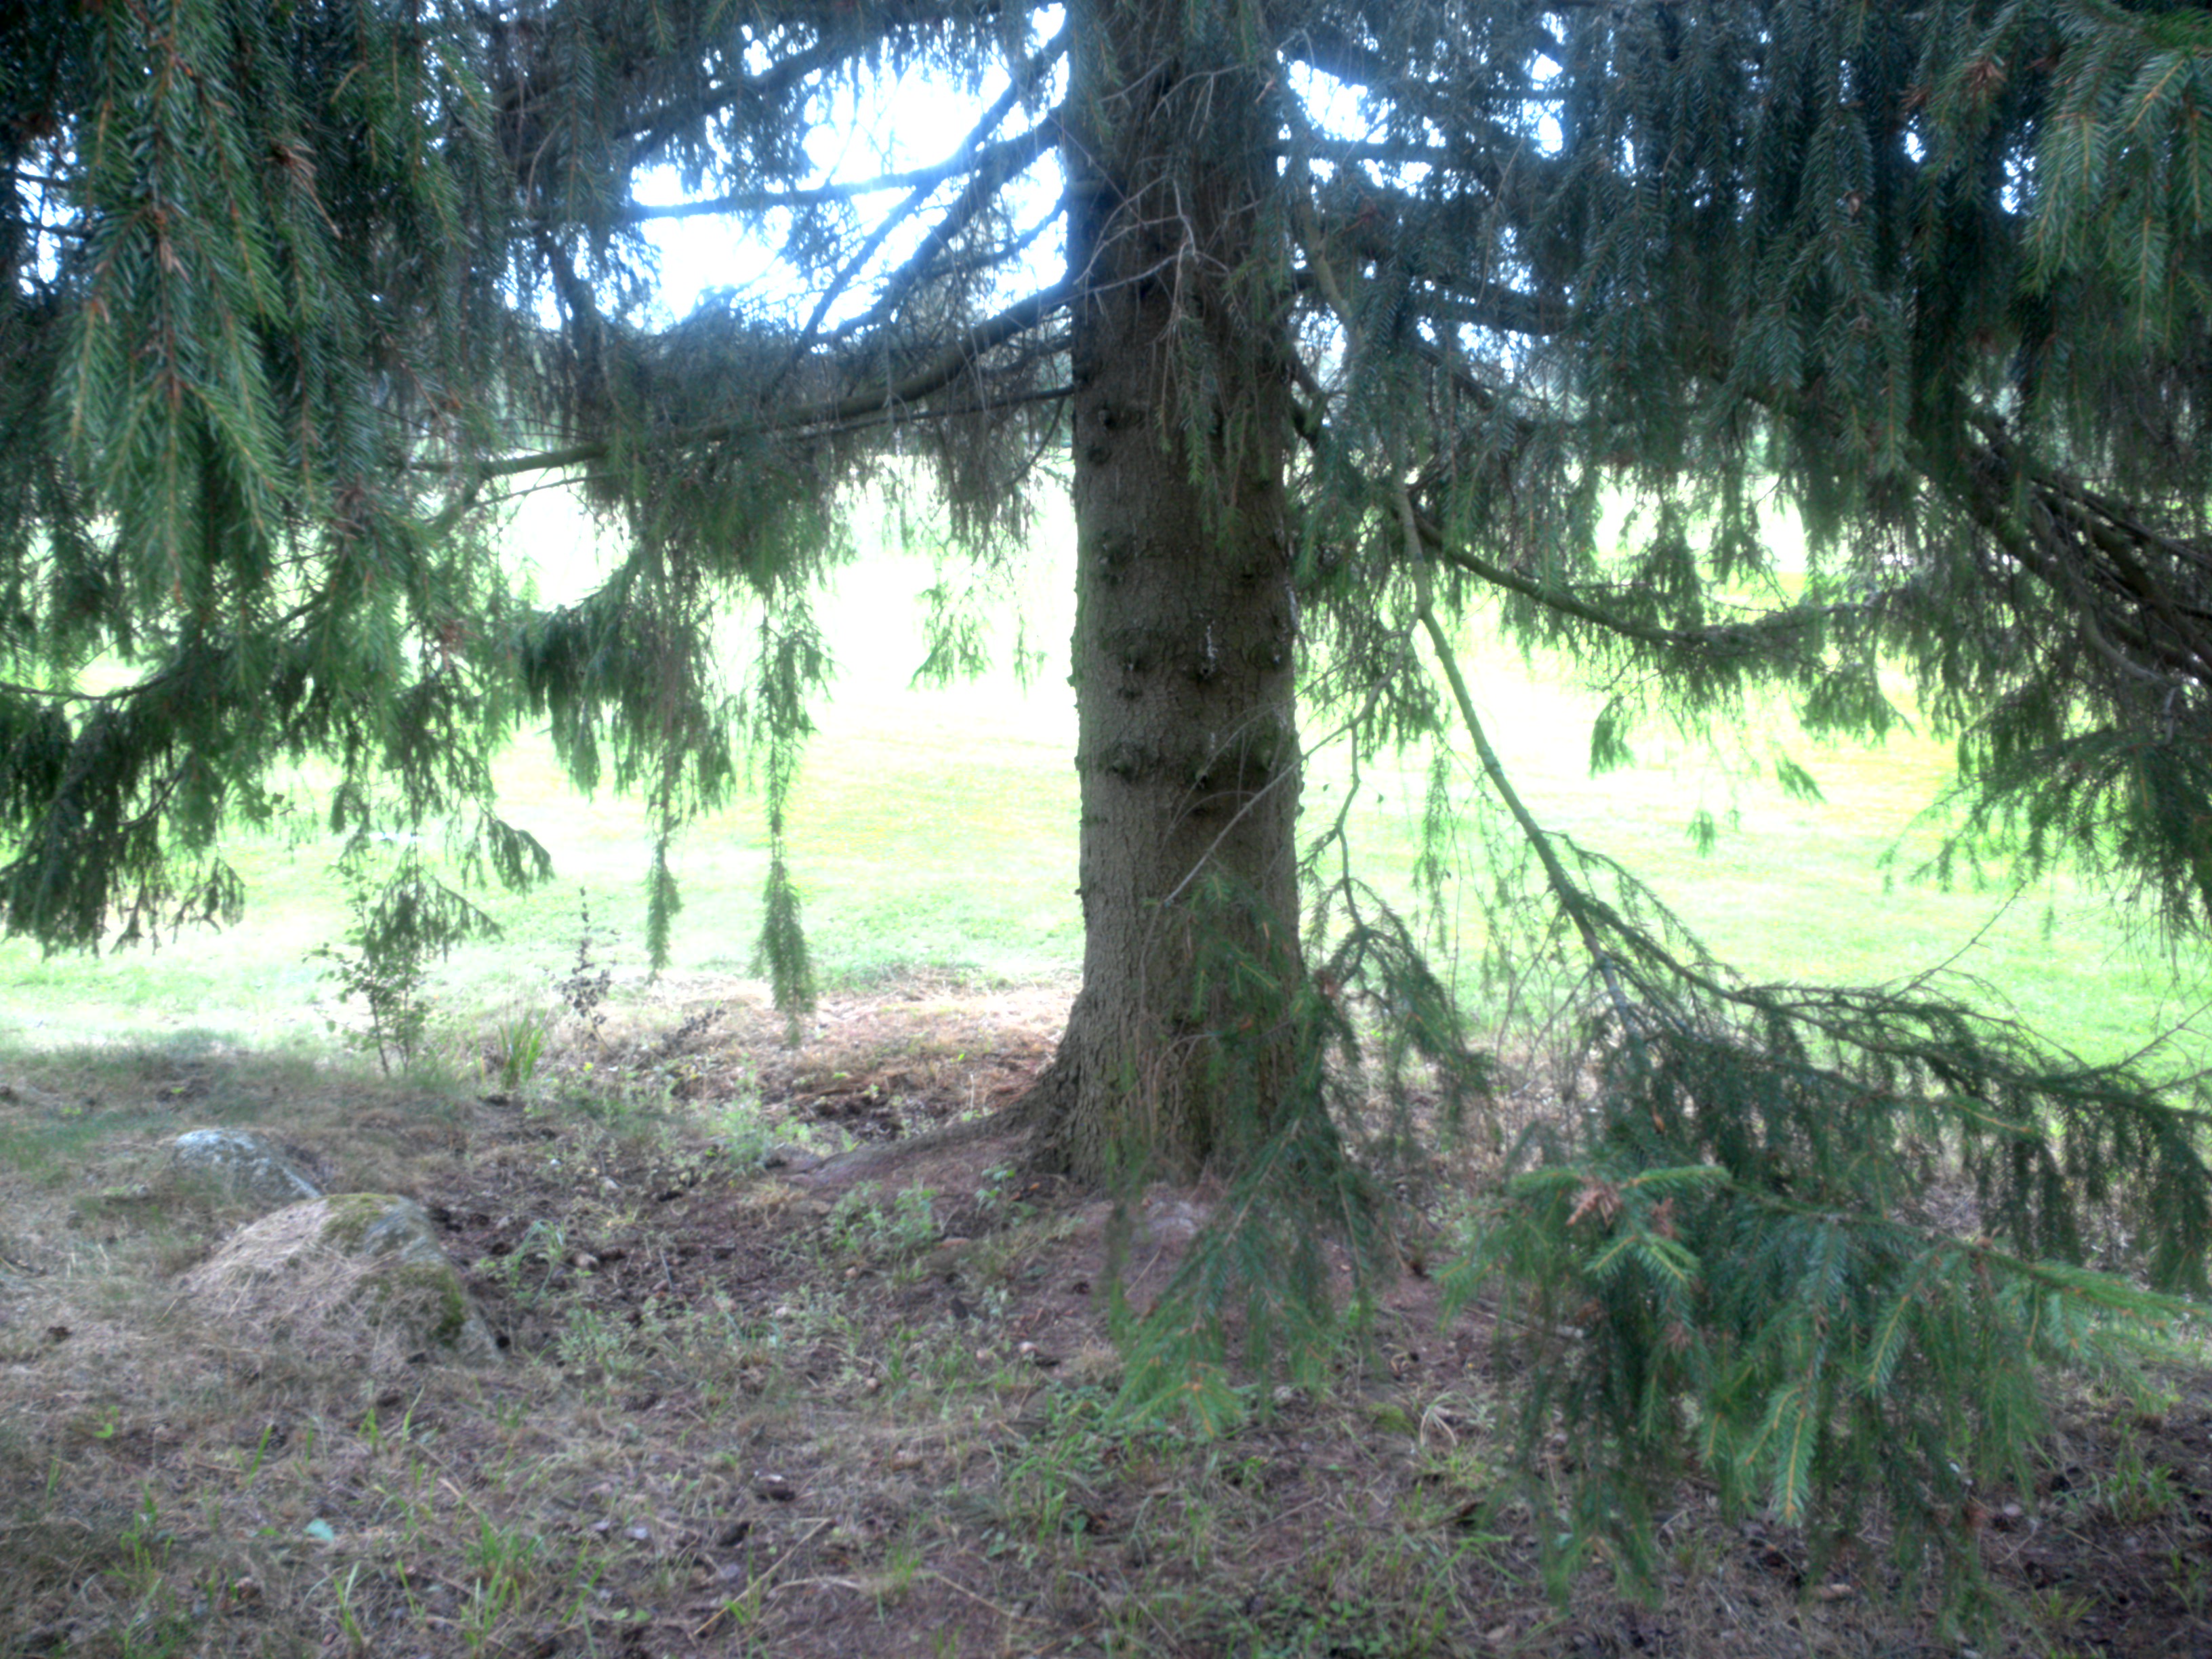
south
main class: Grassland
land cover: Grassland with sparse tree/shrub cover
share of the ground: > 75 %
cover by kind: herbaceous plants 95 %, broadleaved forest trees 5 %
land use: Sport
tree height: > 5 m
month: July
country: SE
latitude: 59.2523
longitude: 18.2242
